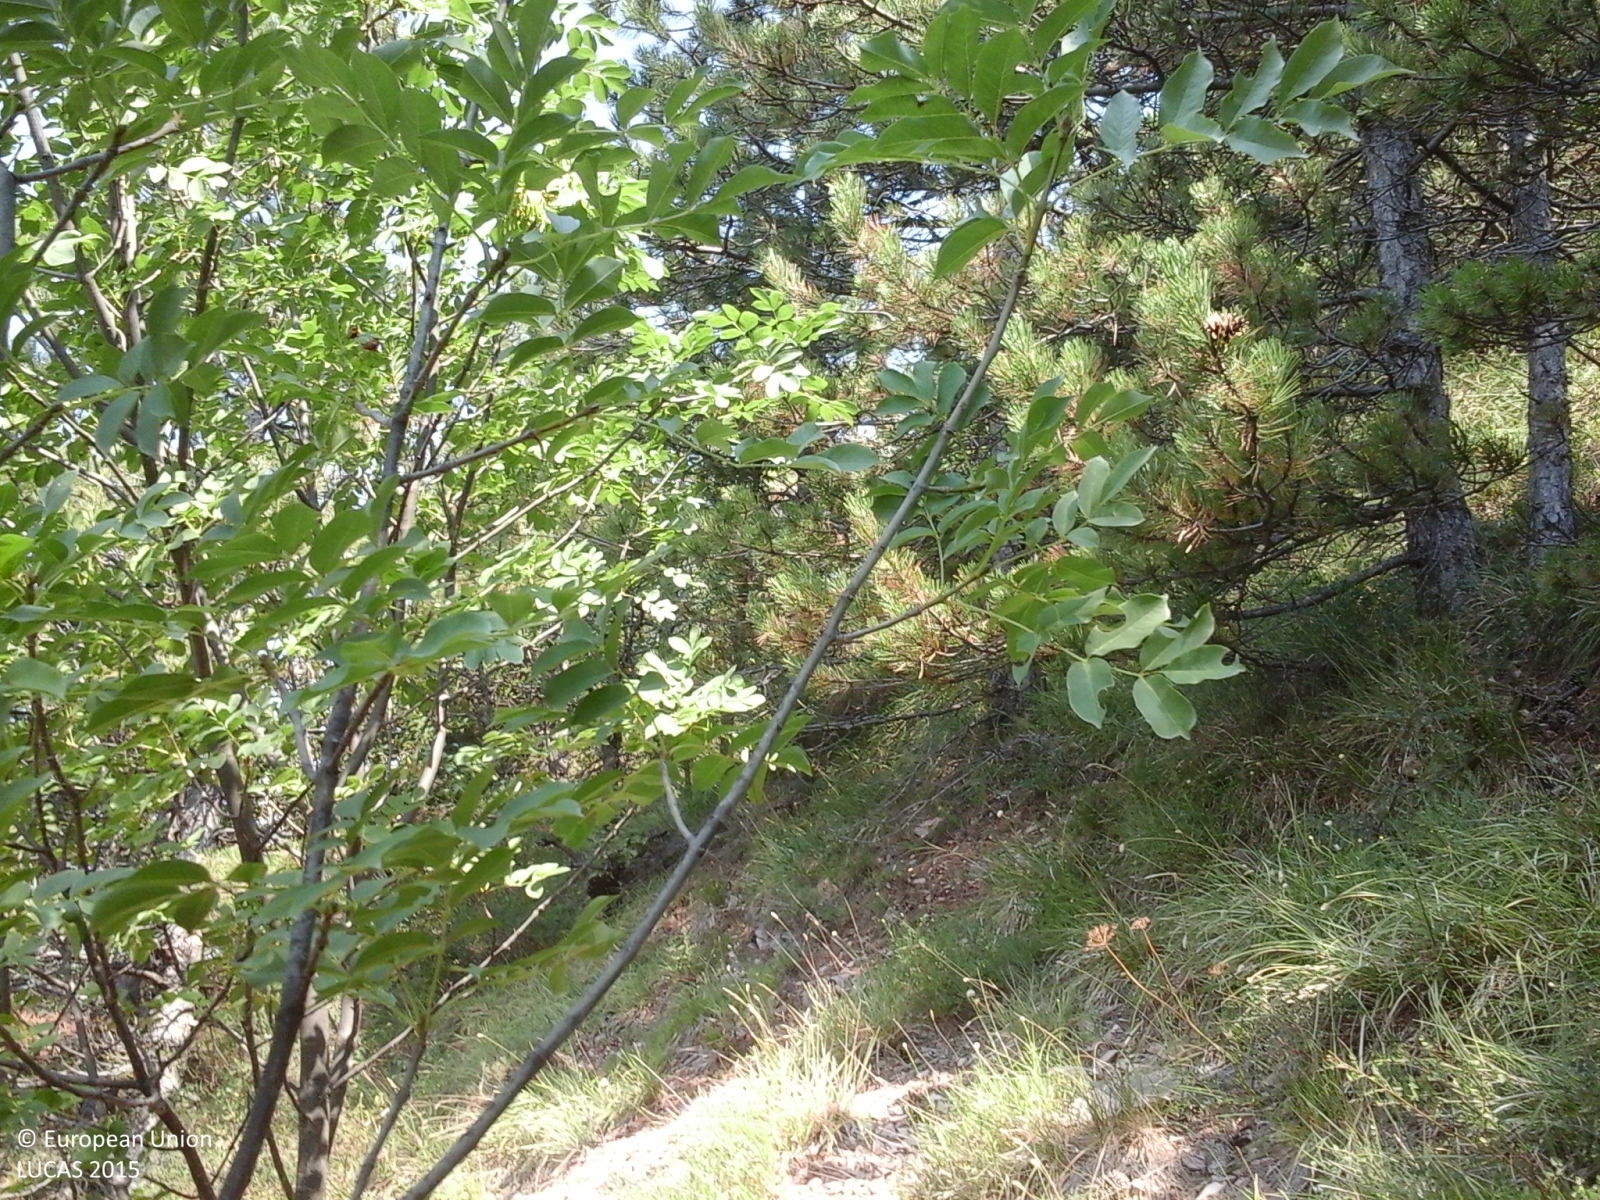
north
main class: Woodland
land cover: Other mixed woodland
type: thermophilous deciduous forest
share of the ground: > 75 %
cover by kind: broadleaved forest trees 75 %, coniferous forest trees 25 %
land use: Forestry
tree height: < 5 m
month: August
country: IT
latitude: 43.0216
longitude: 13.1203
